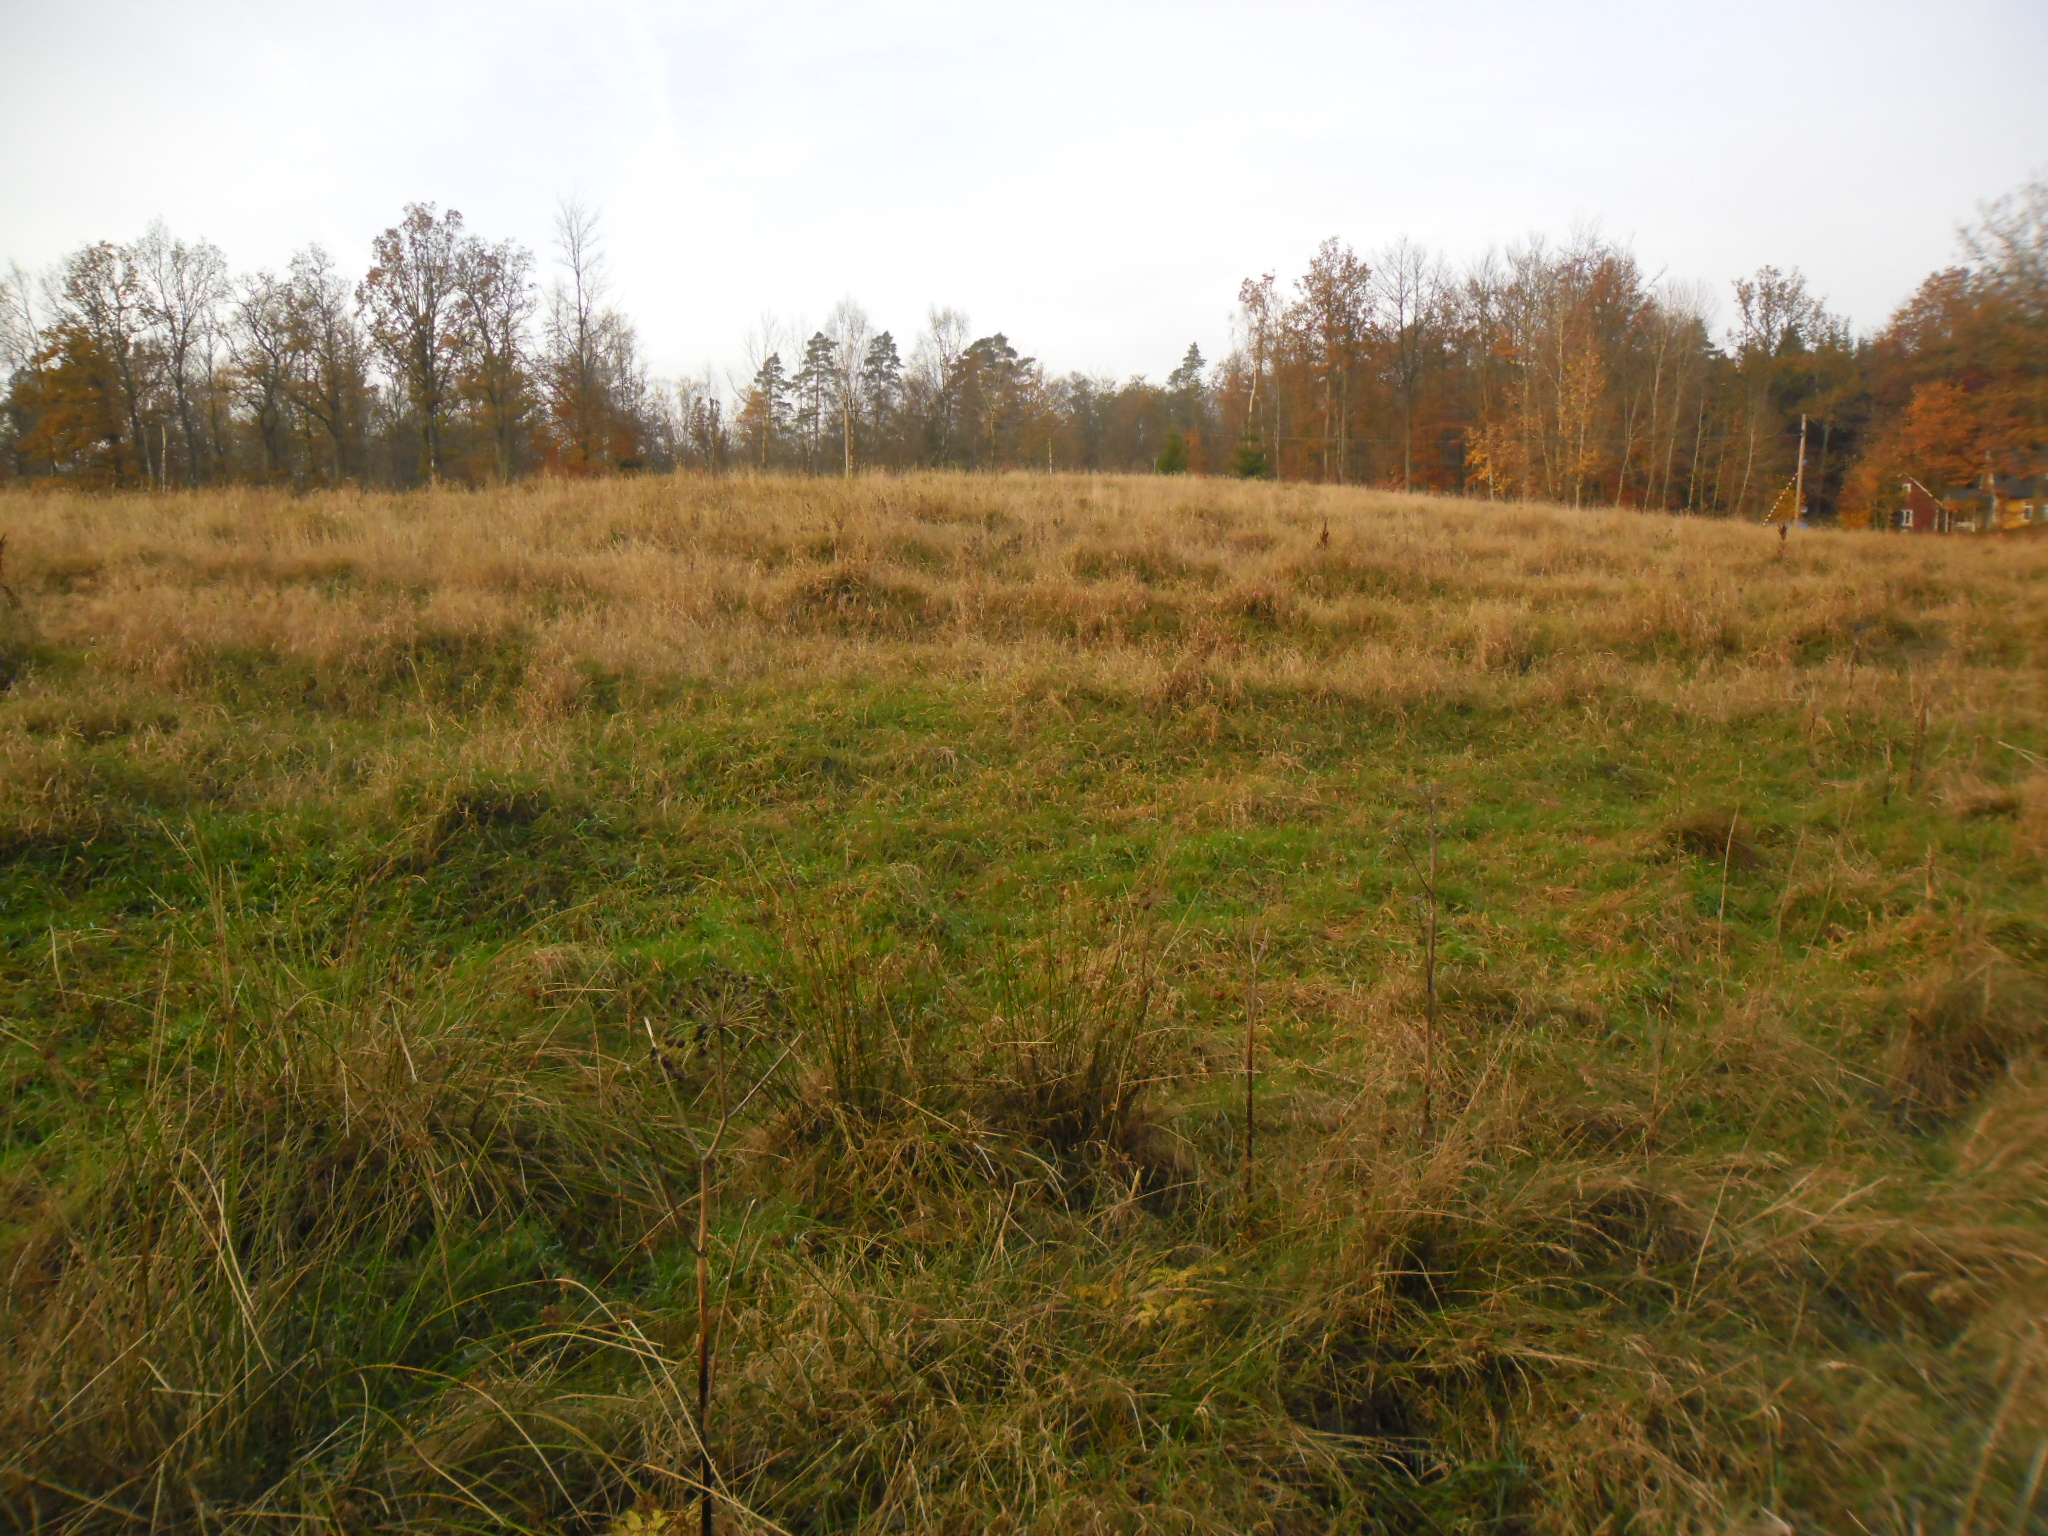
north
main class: Grassland
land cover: Grassland without tree/shrub cover
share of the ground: > 75 %
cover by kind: herbaceous plants 100 %
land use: Semi-natural and natural areas not in use
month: November
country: SE
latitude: 56.2580
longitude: 13.1128
